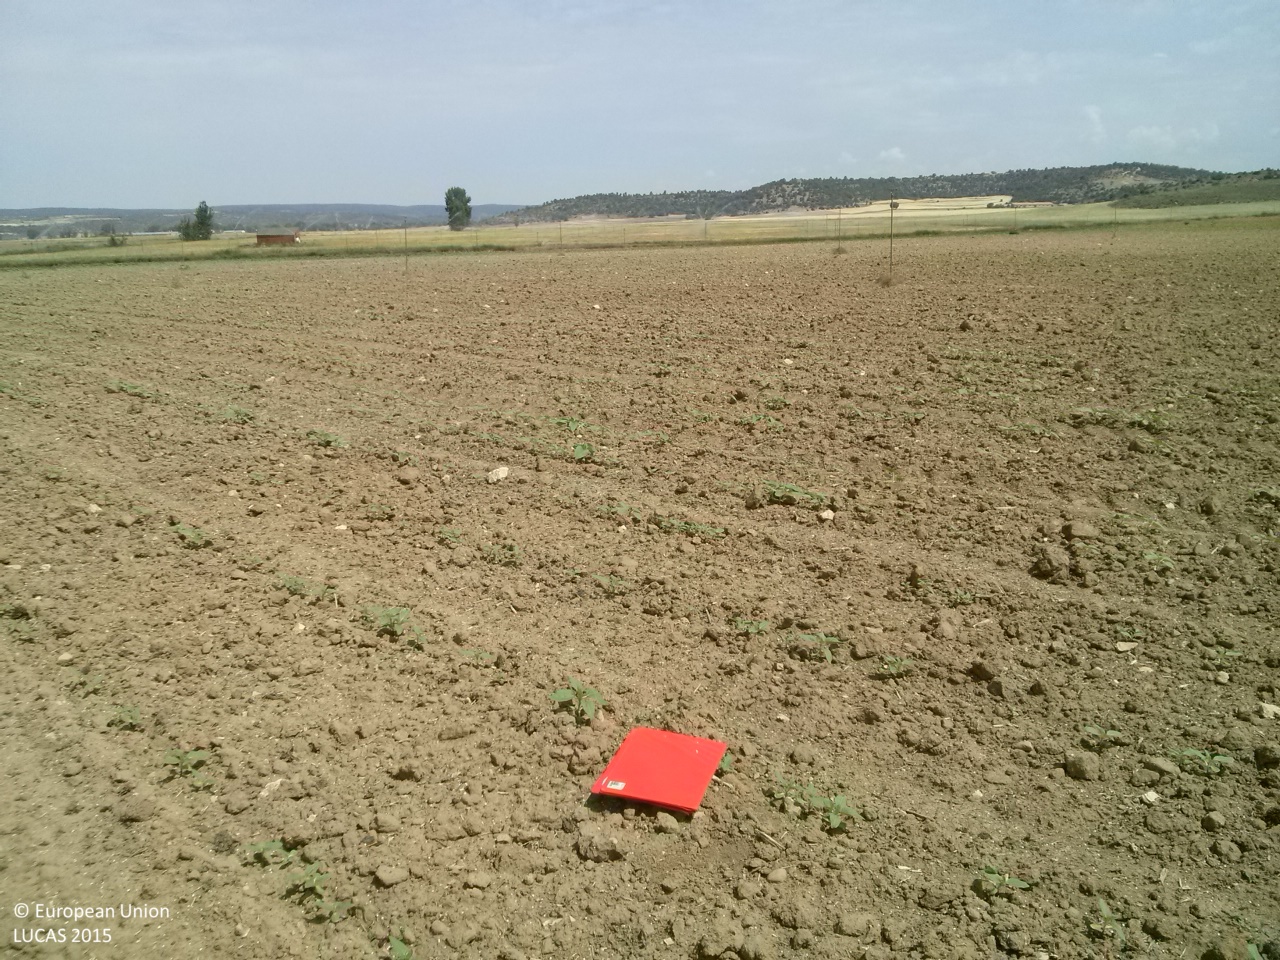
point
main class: Cropland
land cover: Sunflower
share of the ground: < 10 %
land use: Agriculture (excluding fallow land and kitchen gardens)
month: June
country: ES
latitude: 39.9311
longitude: -1.8419
